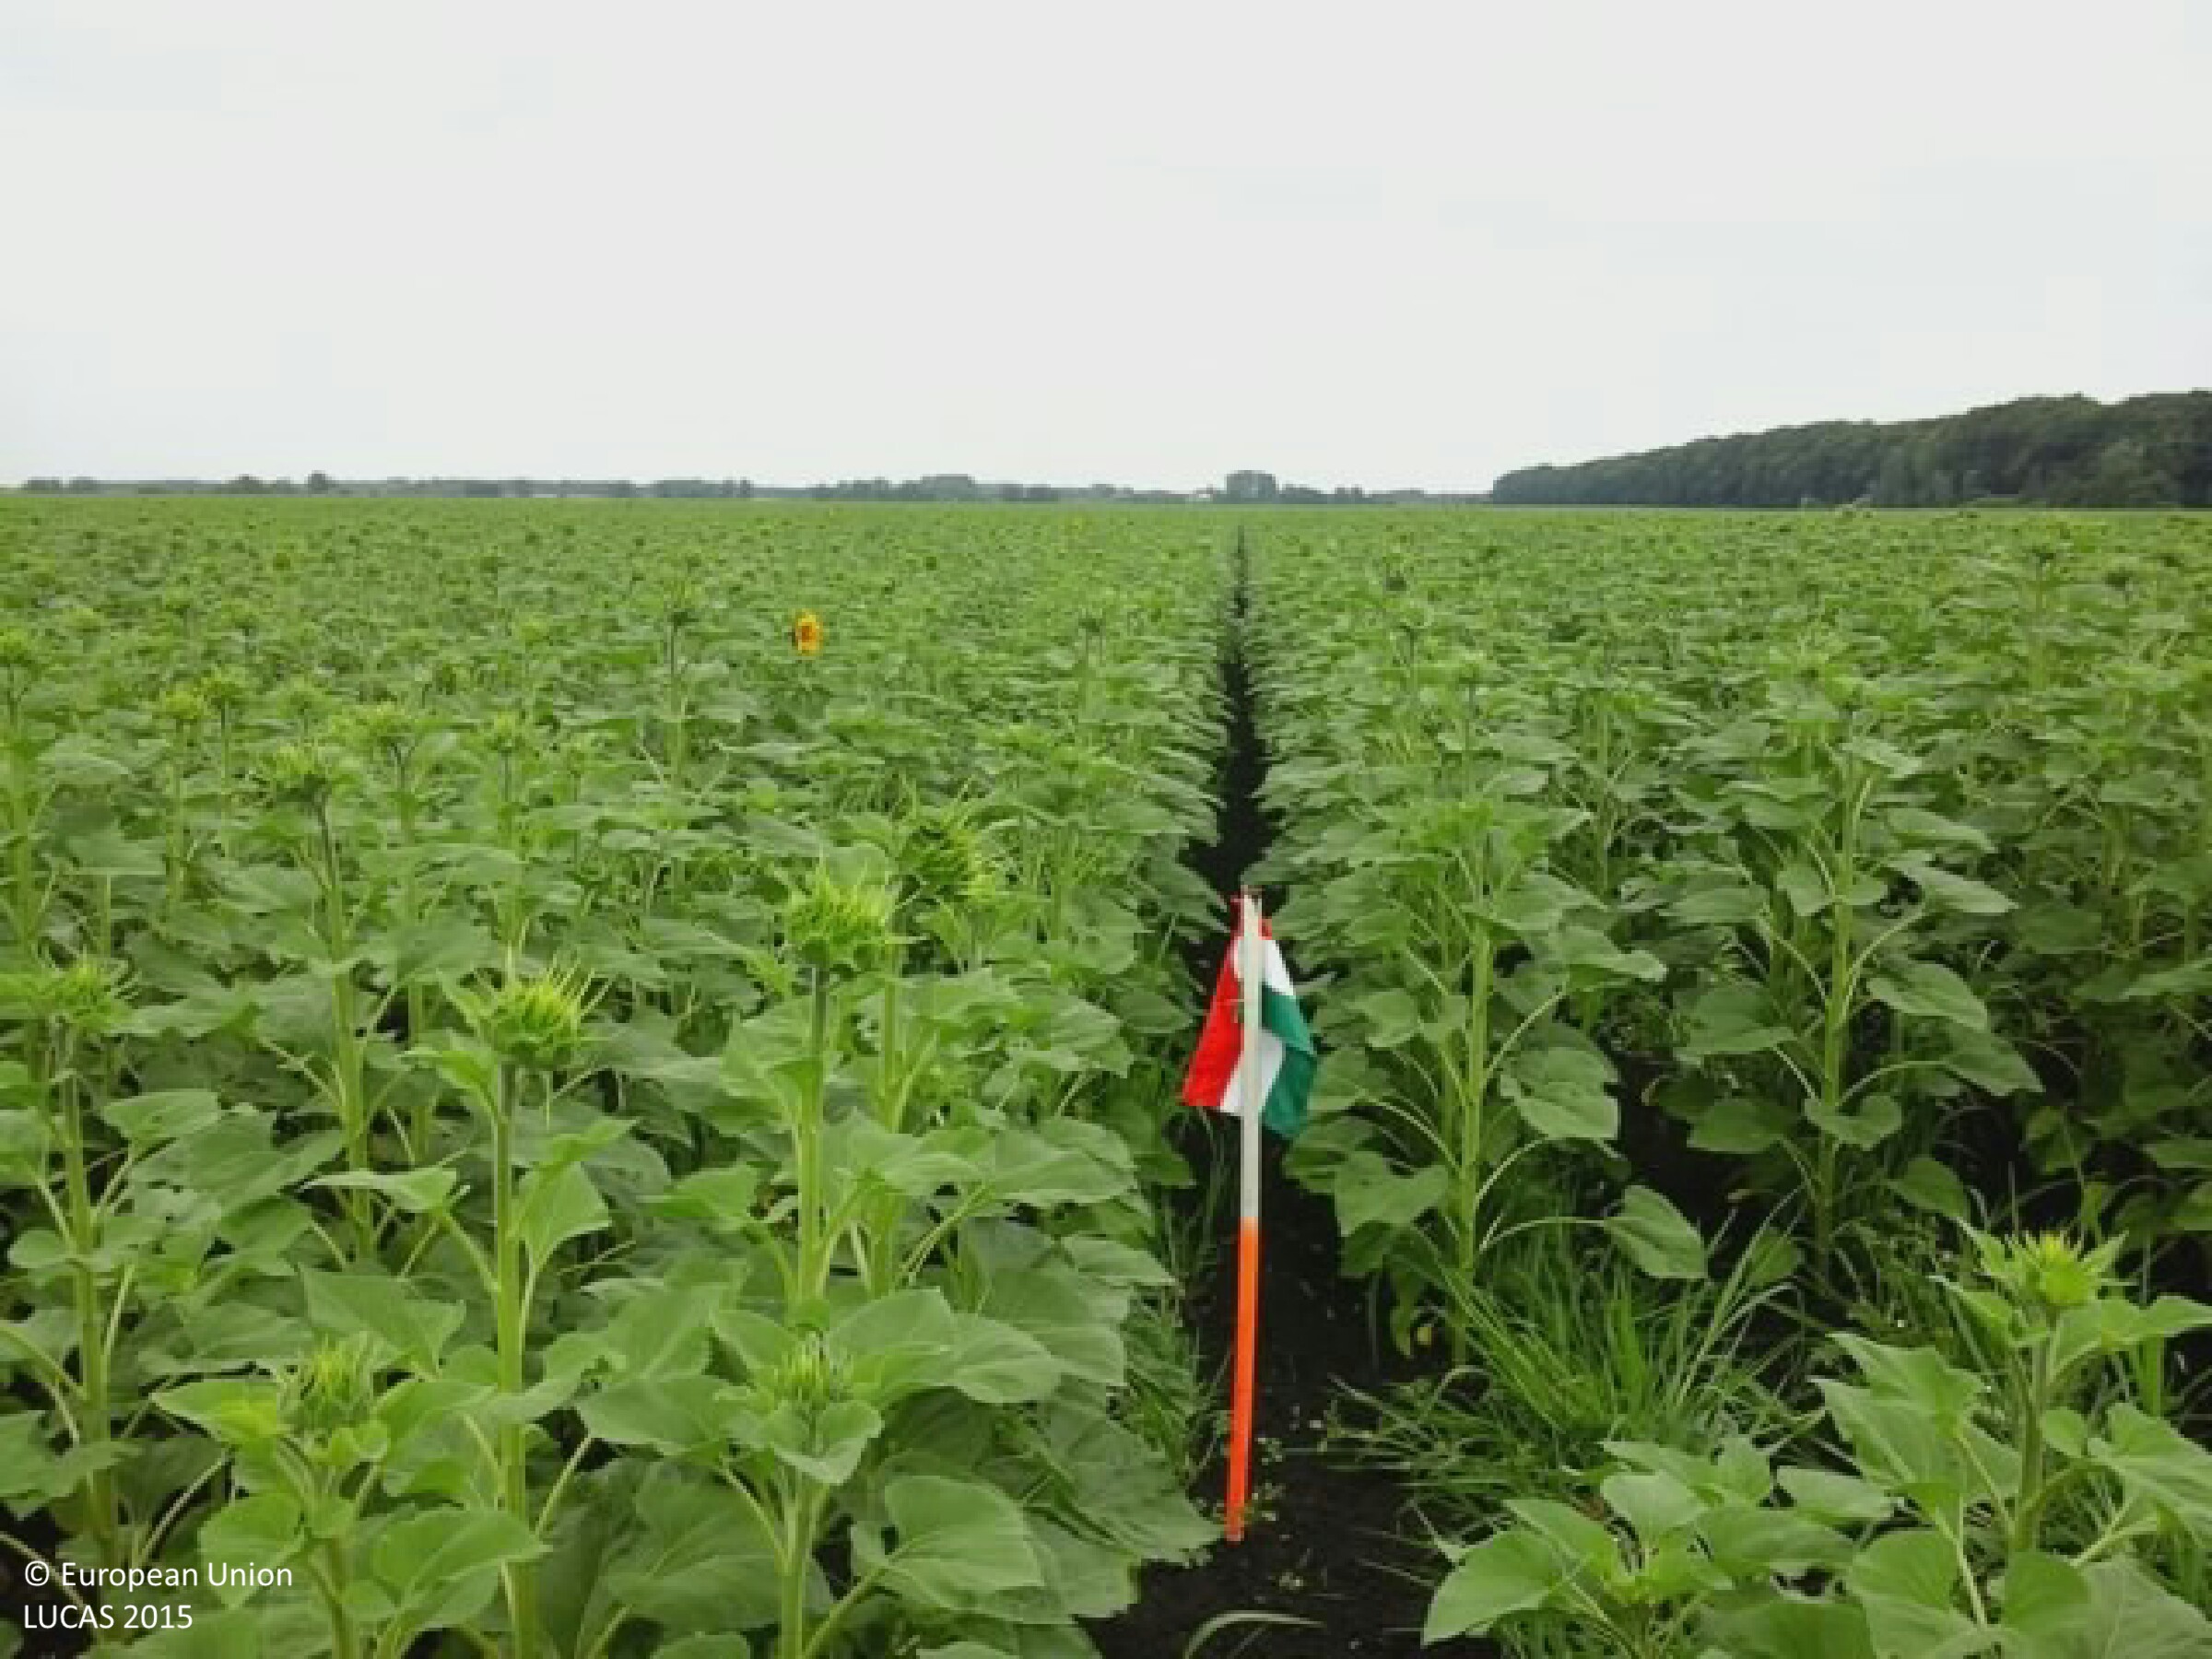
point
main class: Cropland
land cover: Sunflower
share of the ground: > 75 %
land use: Agriculture (excluding fallow land and kitchen gardens)
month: June
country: HU
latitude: 46.5227
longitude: 20.1256
